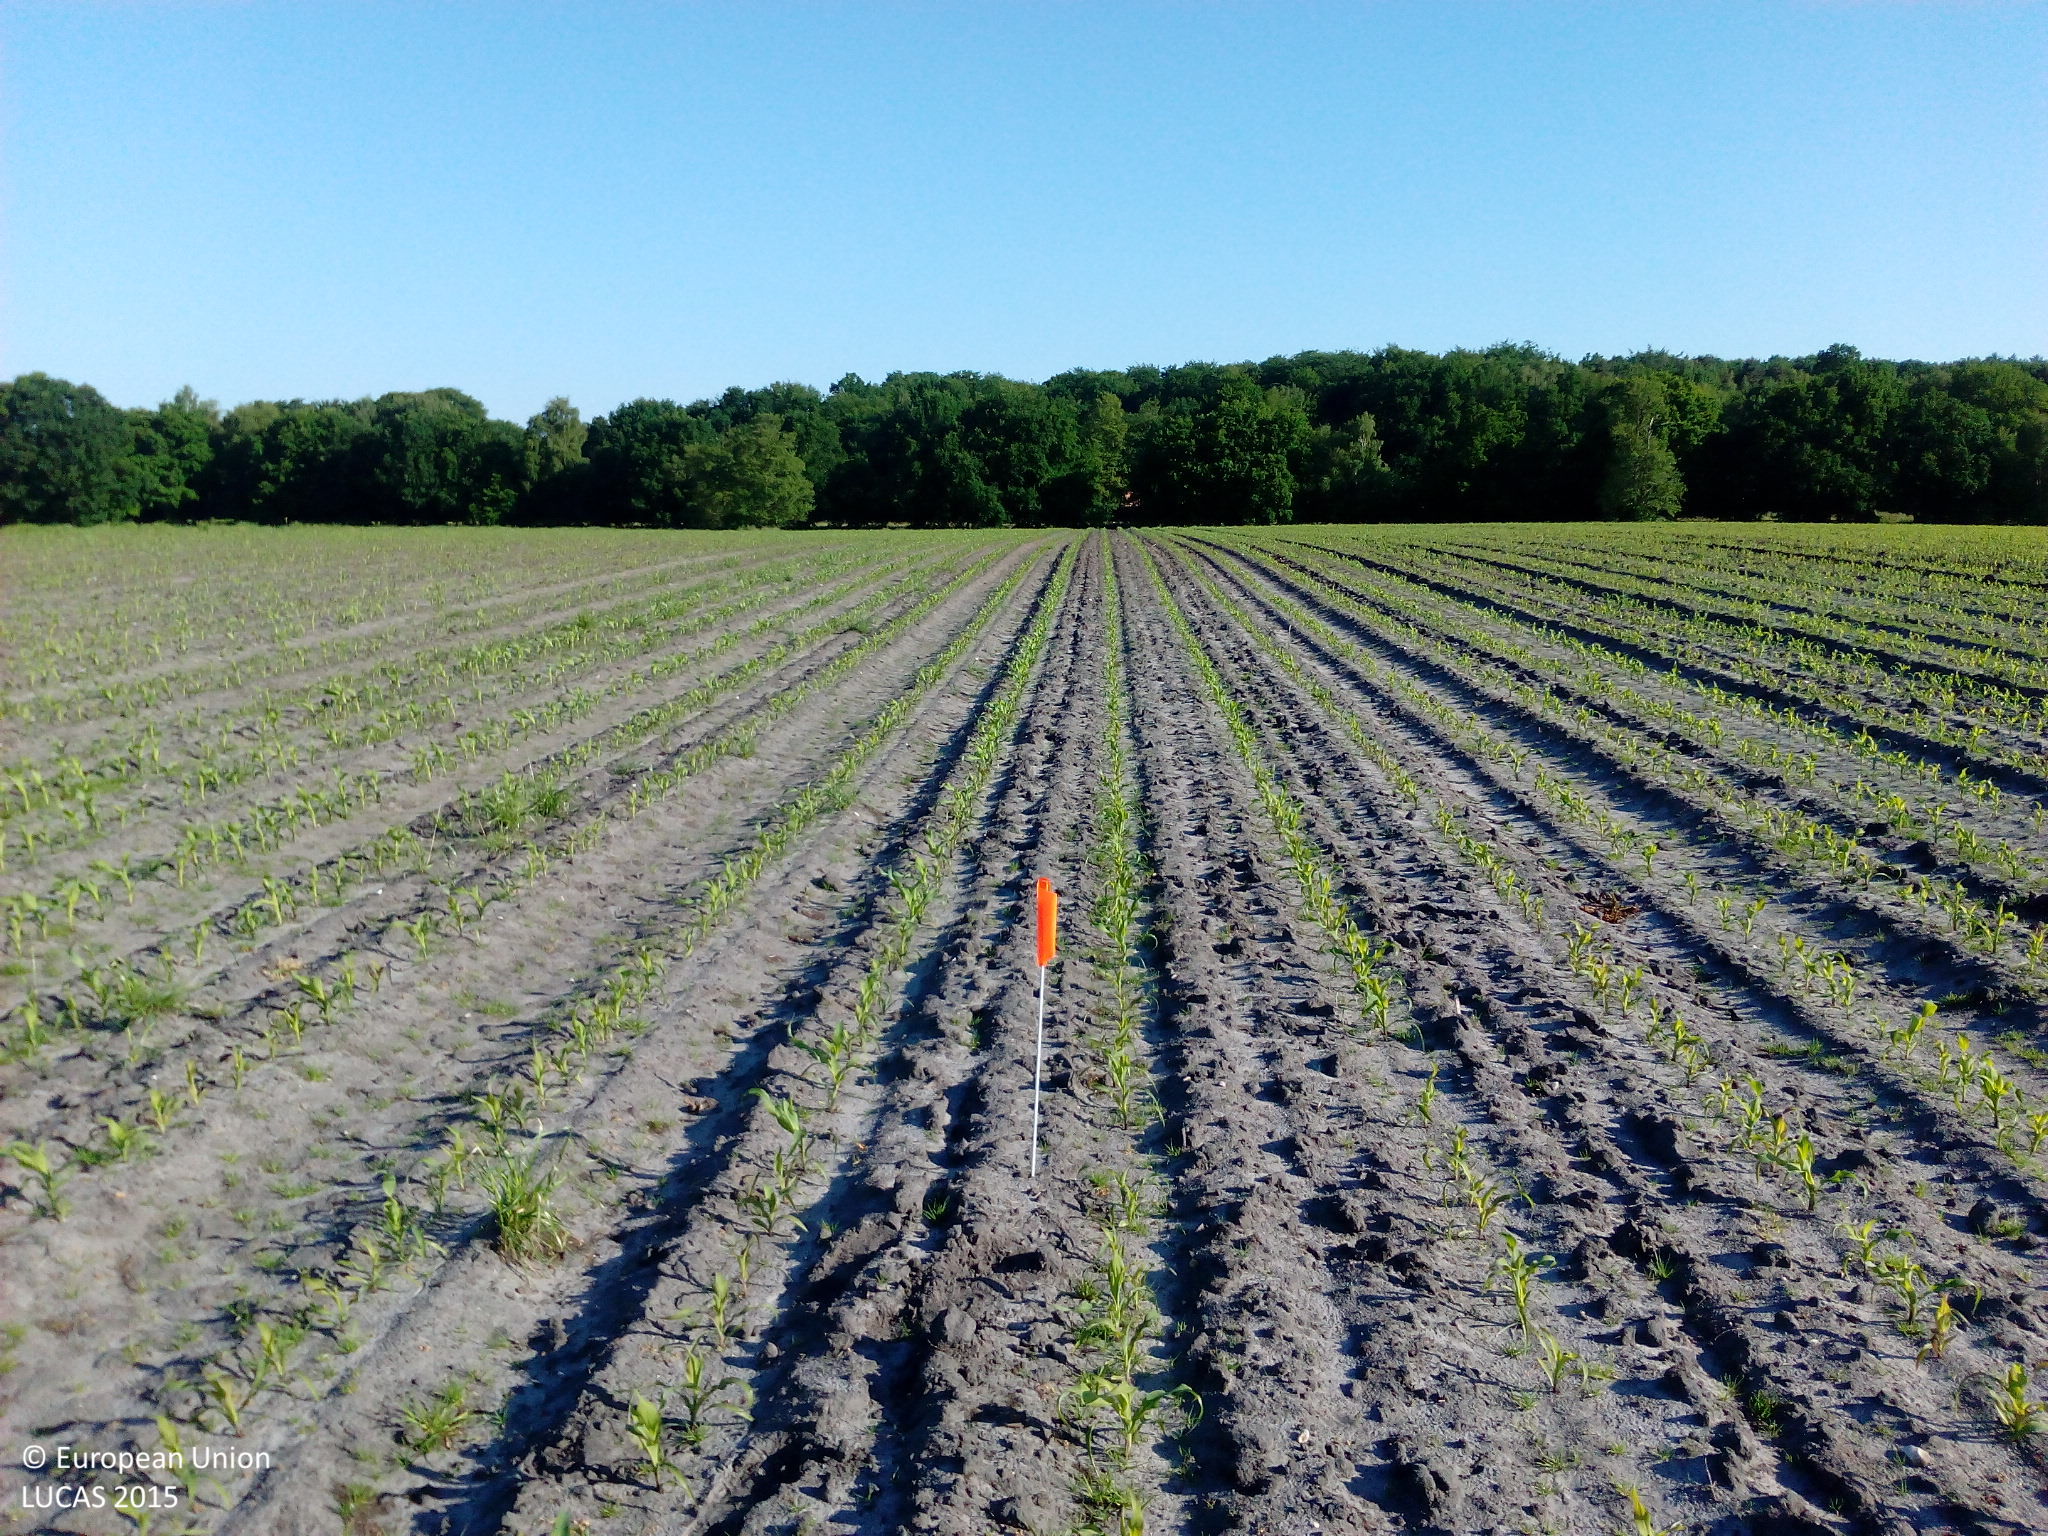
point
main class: Cropland
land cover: Maize
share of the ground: < 10 %
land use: Agriculture (excluding fallow land and kitchen gardens)
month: June
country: DE
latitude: 53.4712
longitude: 9.2019
